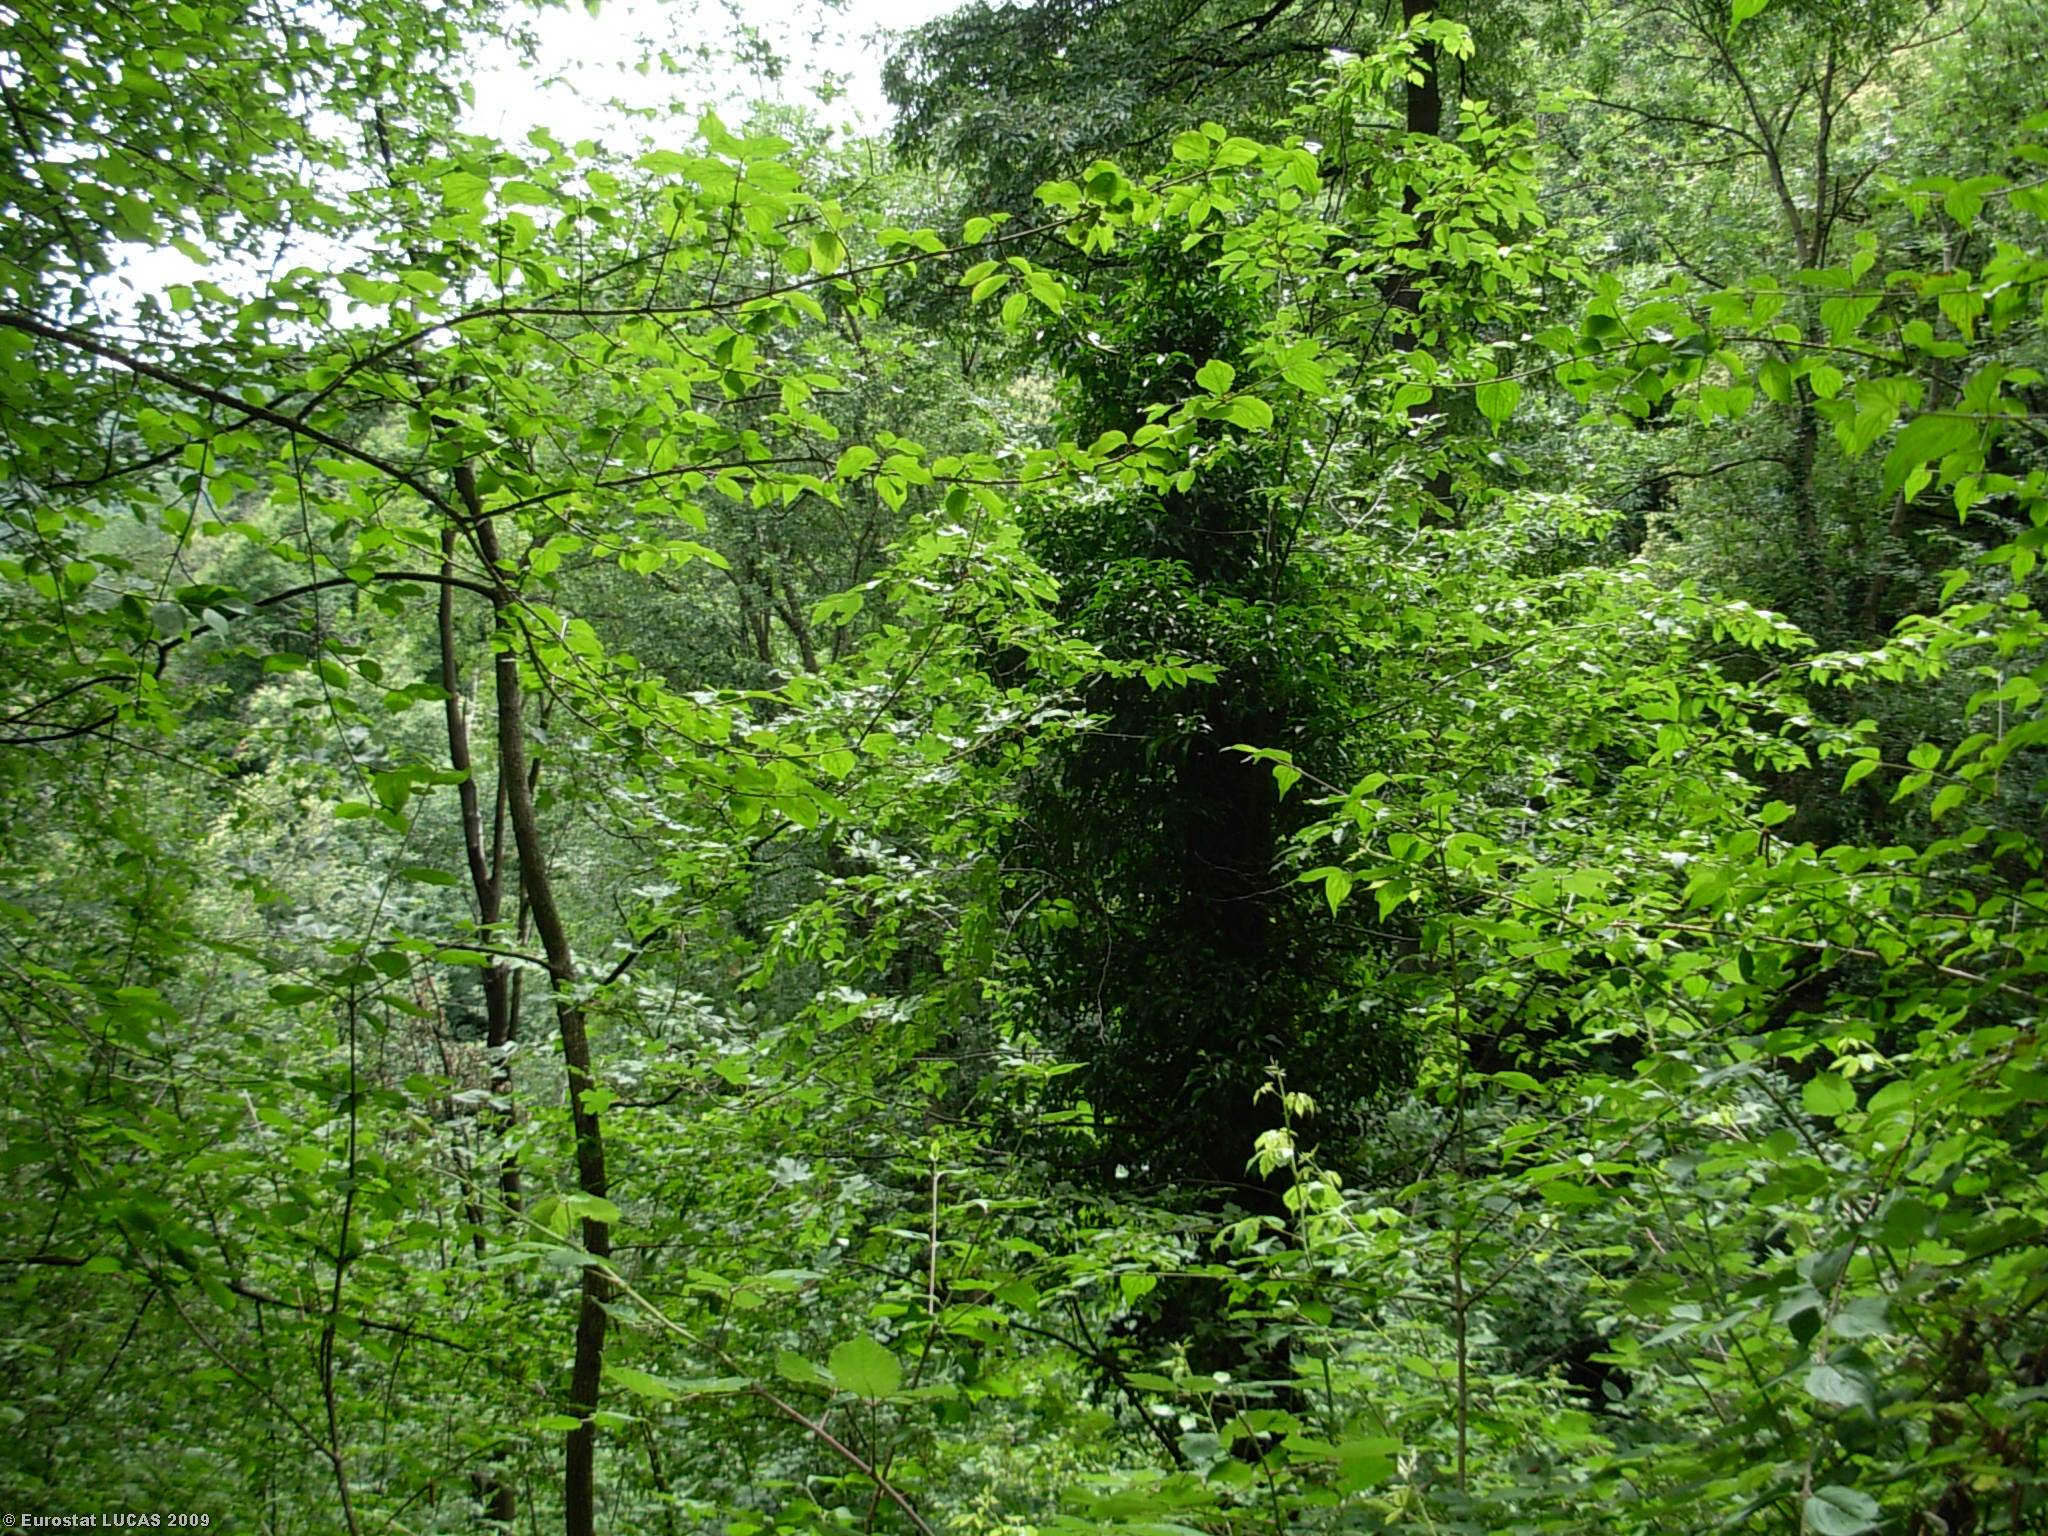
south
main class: Woodland
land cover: Broadleaved woodland
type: mountainous beech forest
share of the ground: > 75 %
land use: Forestry
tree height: > 5 m
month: June
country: IT
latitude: 45.8805
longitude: 9.2924
